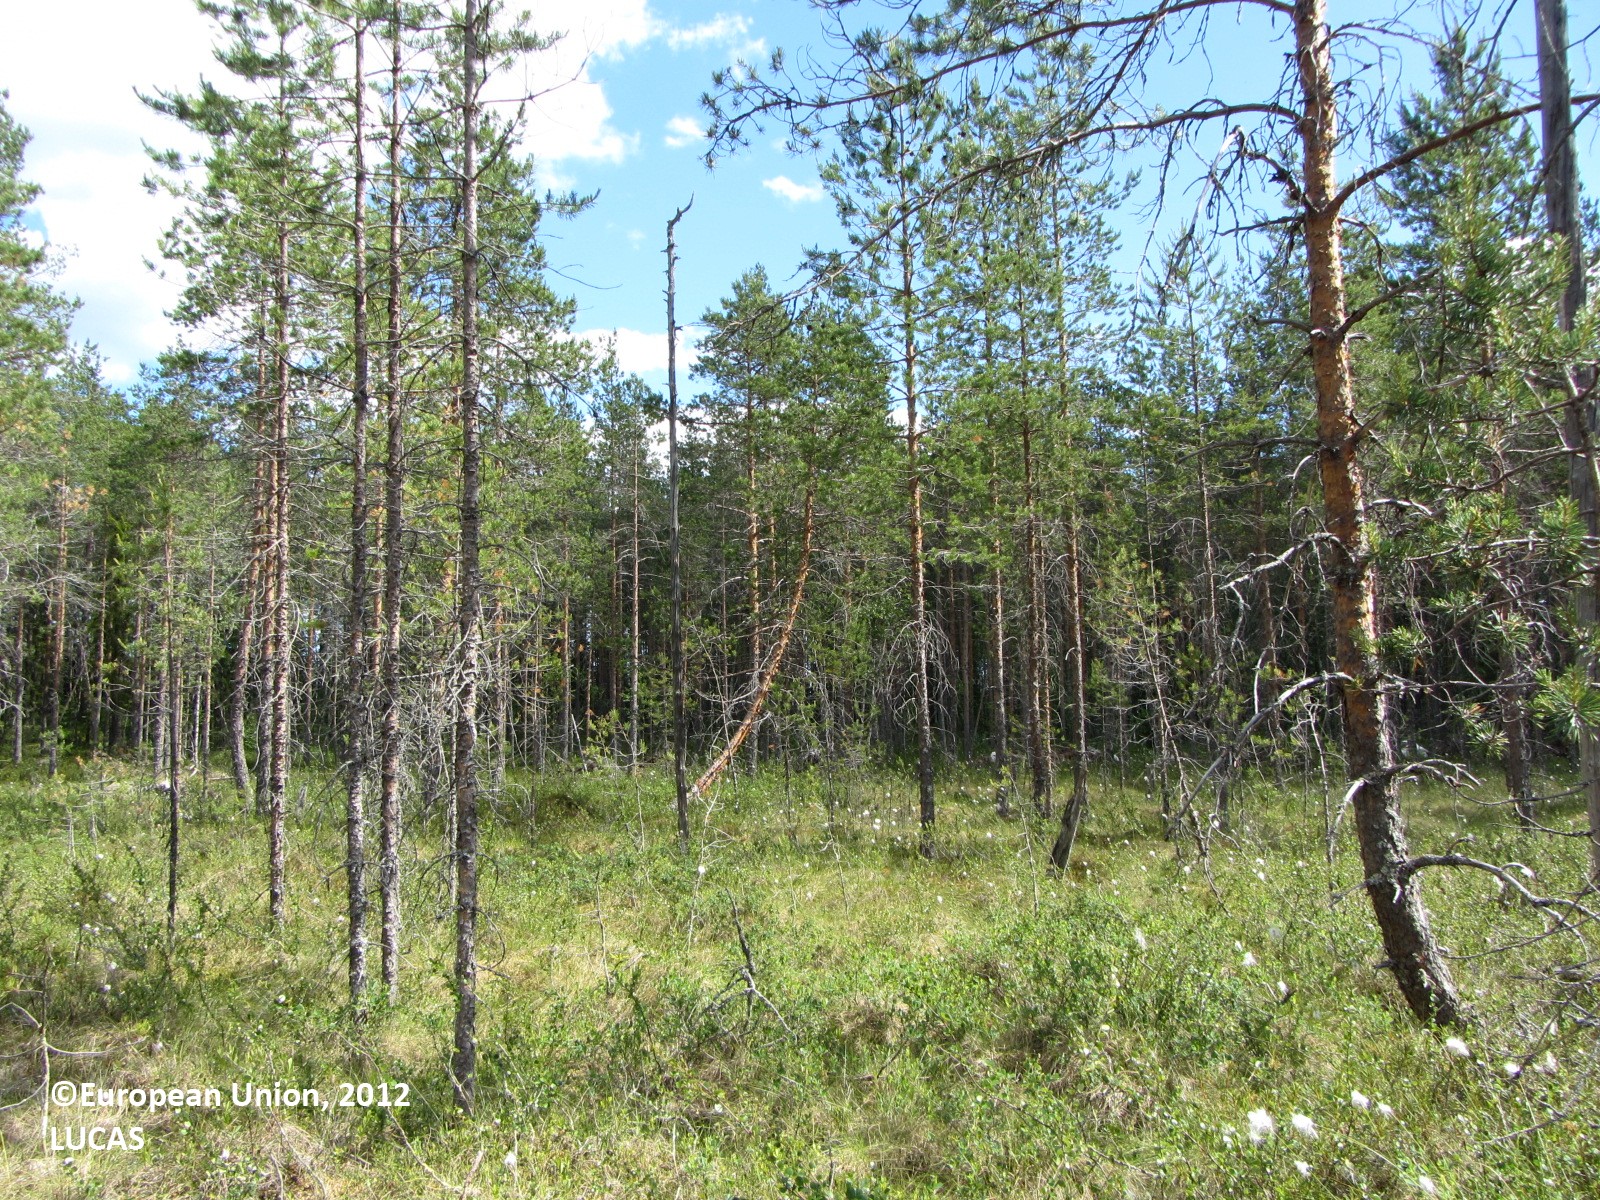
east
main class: Woodland
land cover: Pine dominated coniferous woodland
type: boreal forest
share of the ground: 50 - 75 %
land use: Forestry
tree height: > 5 m
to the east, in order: Pine dominated coniferous woodland; Ditches and canals; Pine dominated coniferous woodland; Ditches and canals; Pine dominated coniferous woodland; Ditches and canals; Pine dominated coniferous woodland; Ditches and canals; Pine dominated coniferous woodland; Ditches and canals; Pine dominated coniferous woodland
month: July
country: FI
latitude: 63.2582
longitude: 25.3388
